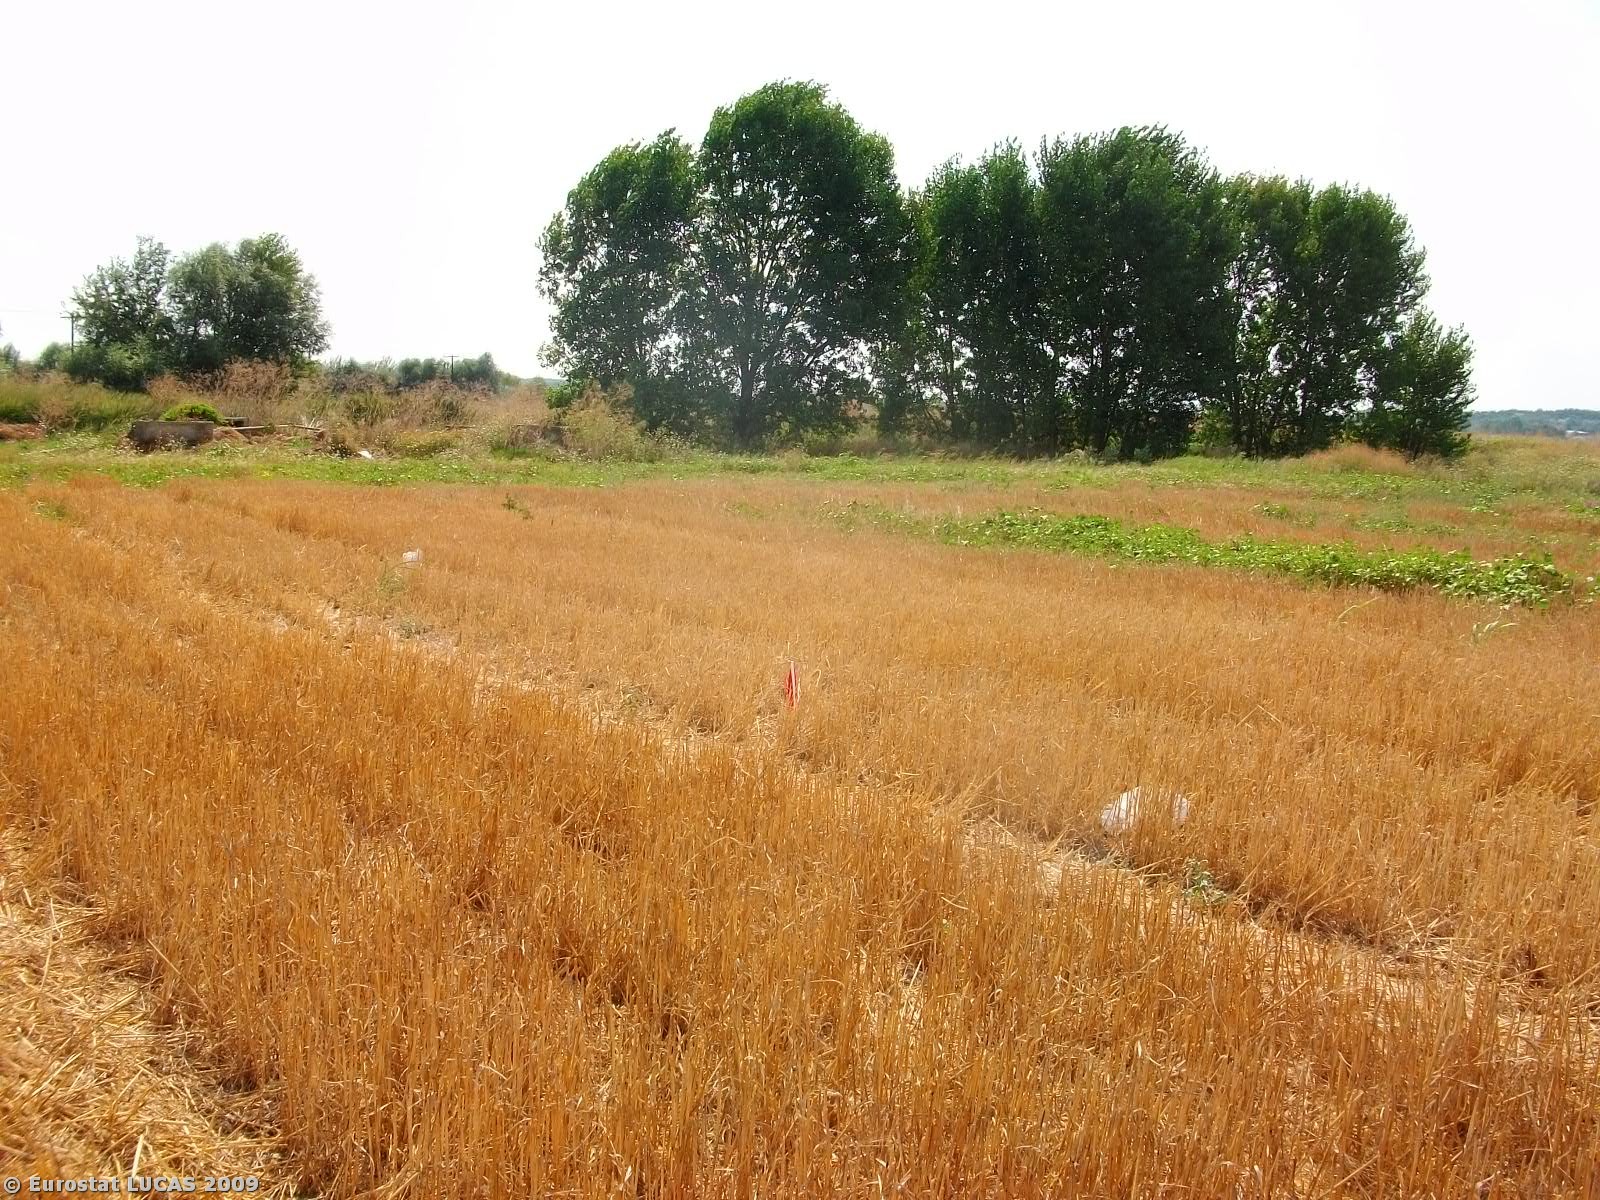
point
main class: Cropland
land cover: Triticale
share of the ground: < 10 %
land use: Agriculture (excluding fallow land and kitchen gardens)
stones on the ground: < 10 %
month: August
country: GR
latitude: 41.4882
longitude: 26.5240
